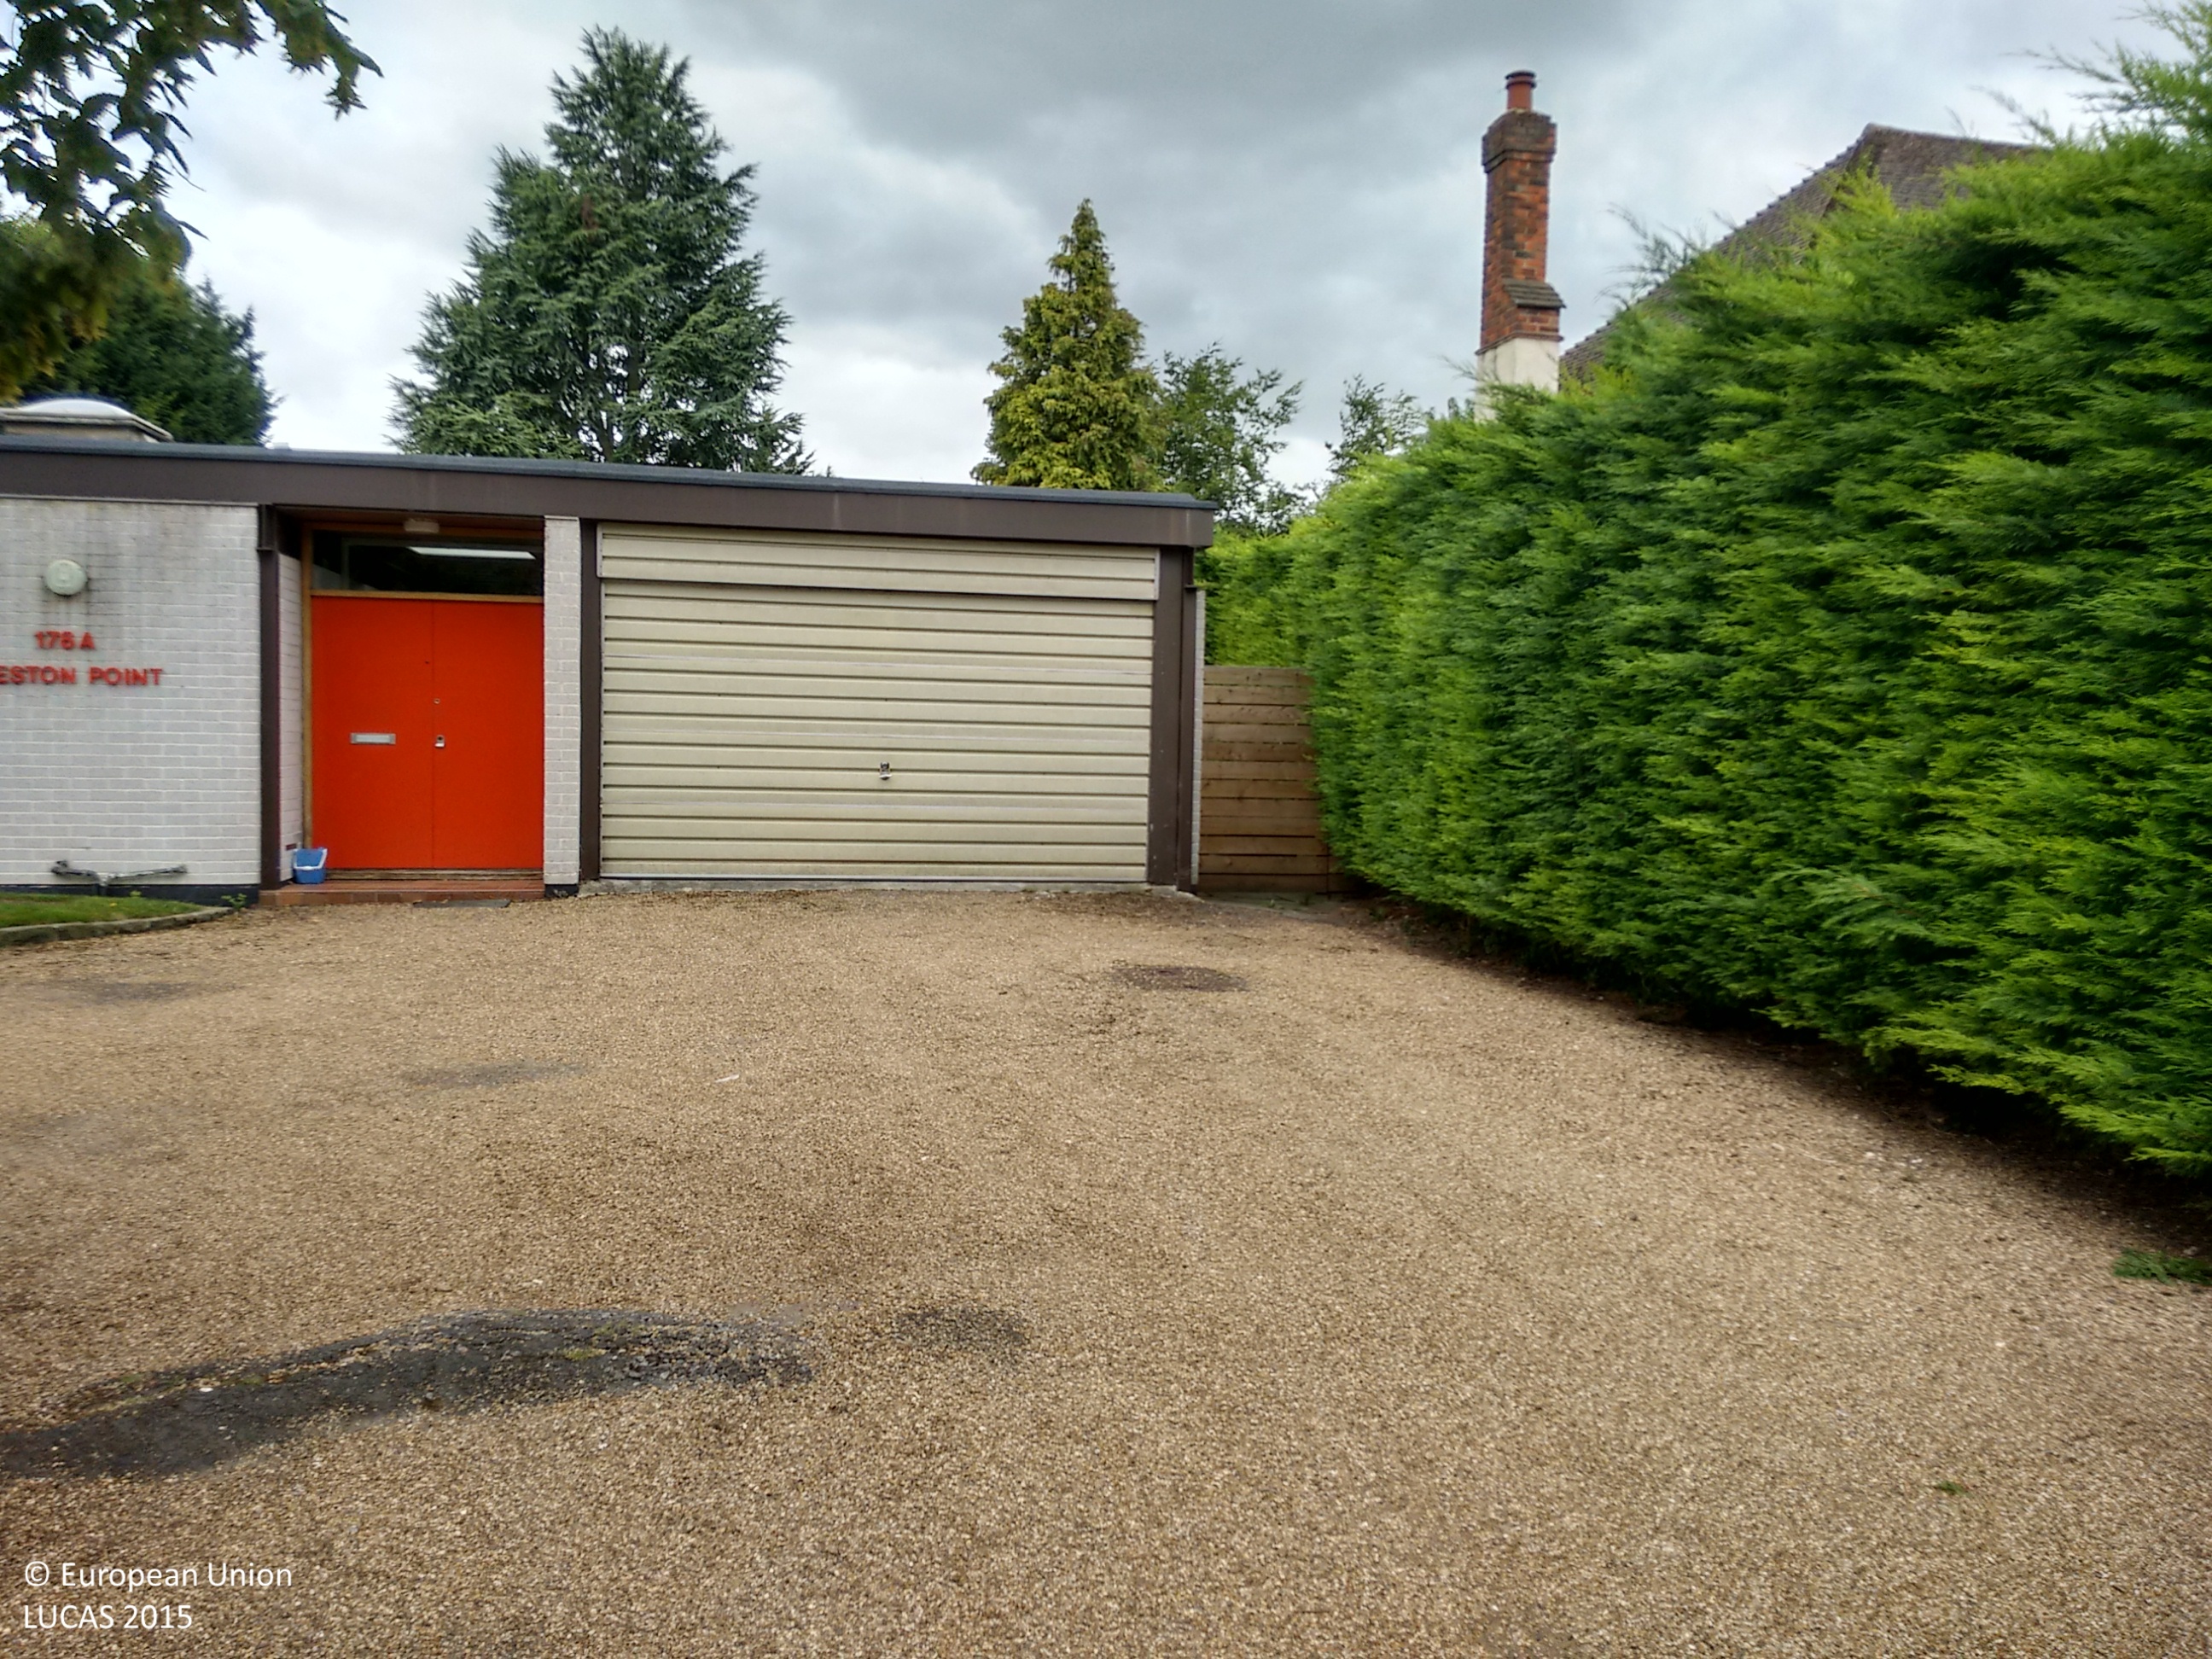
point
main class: Grassland
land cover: Grassland with sparse tree/shrub cover
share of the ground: > 75 %
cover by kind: herbaceous plants 95 %, coniferous forest trees 5 %
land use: Residential
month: August
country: GB
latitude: 51.3377
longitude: -0.2124
